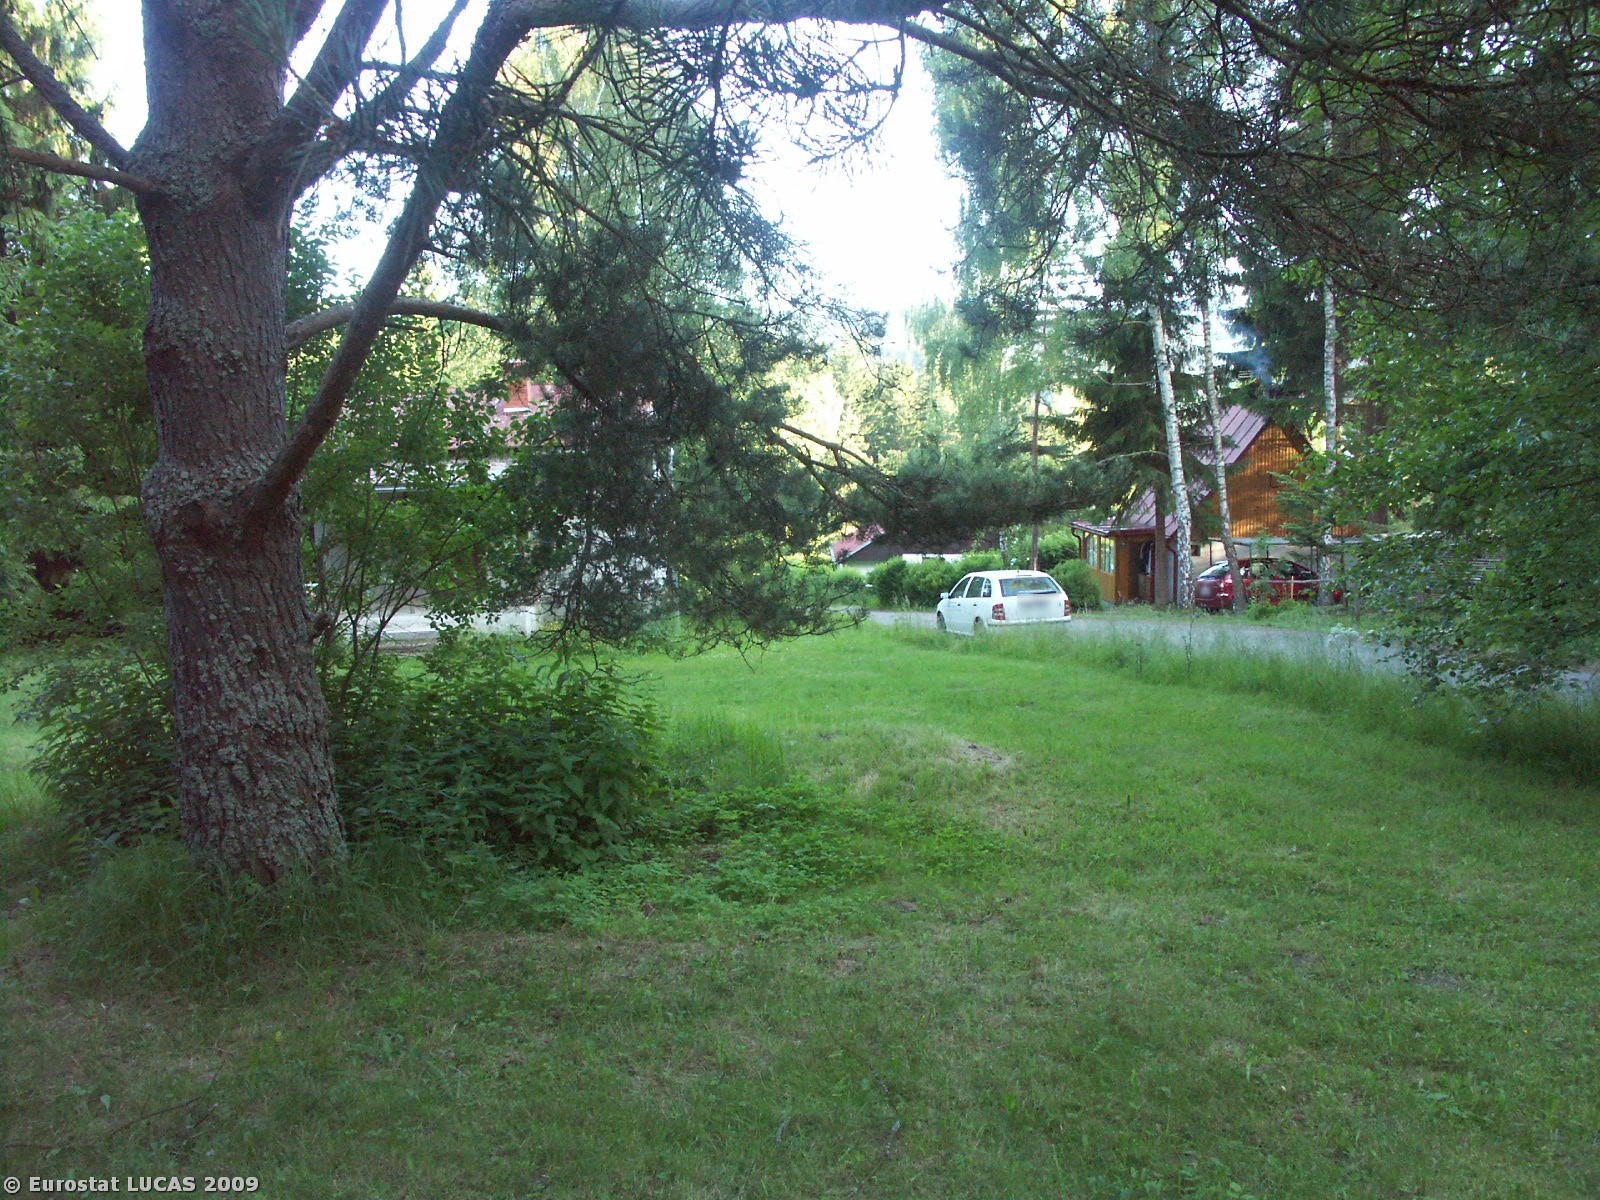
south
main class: Woodland
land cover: Coniferous woodland
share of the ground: 50 - 75 %
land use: Holiday camps
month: June
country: CZ
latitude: 48.6682
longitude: 14.1418
